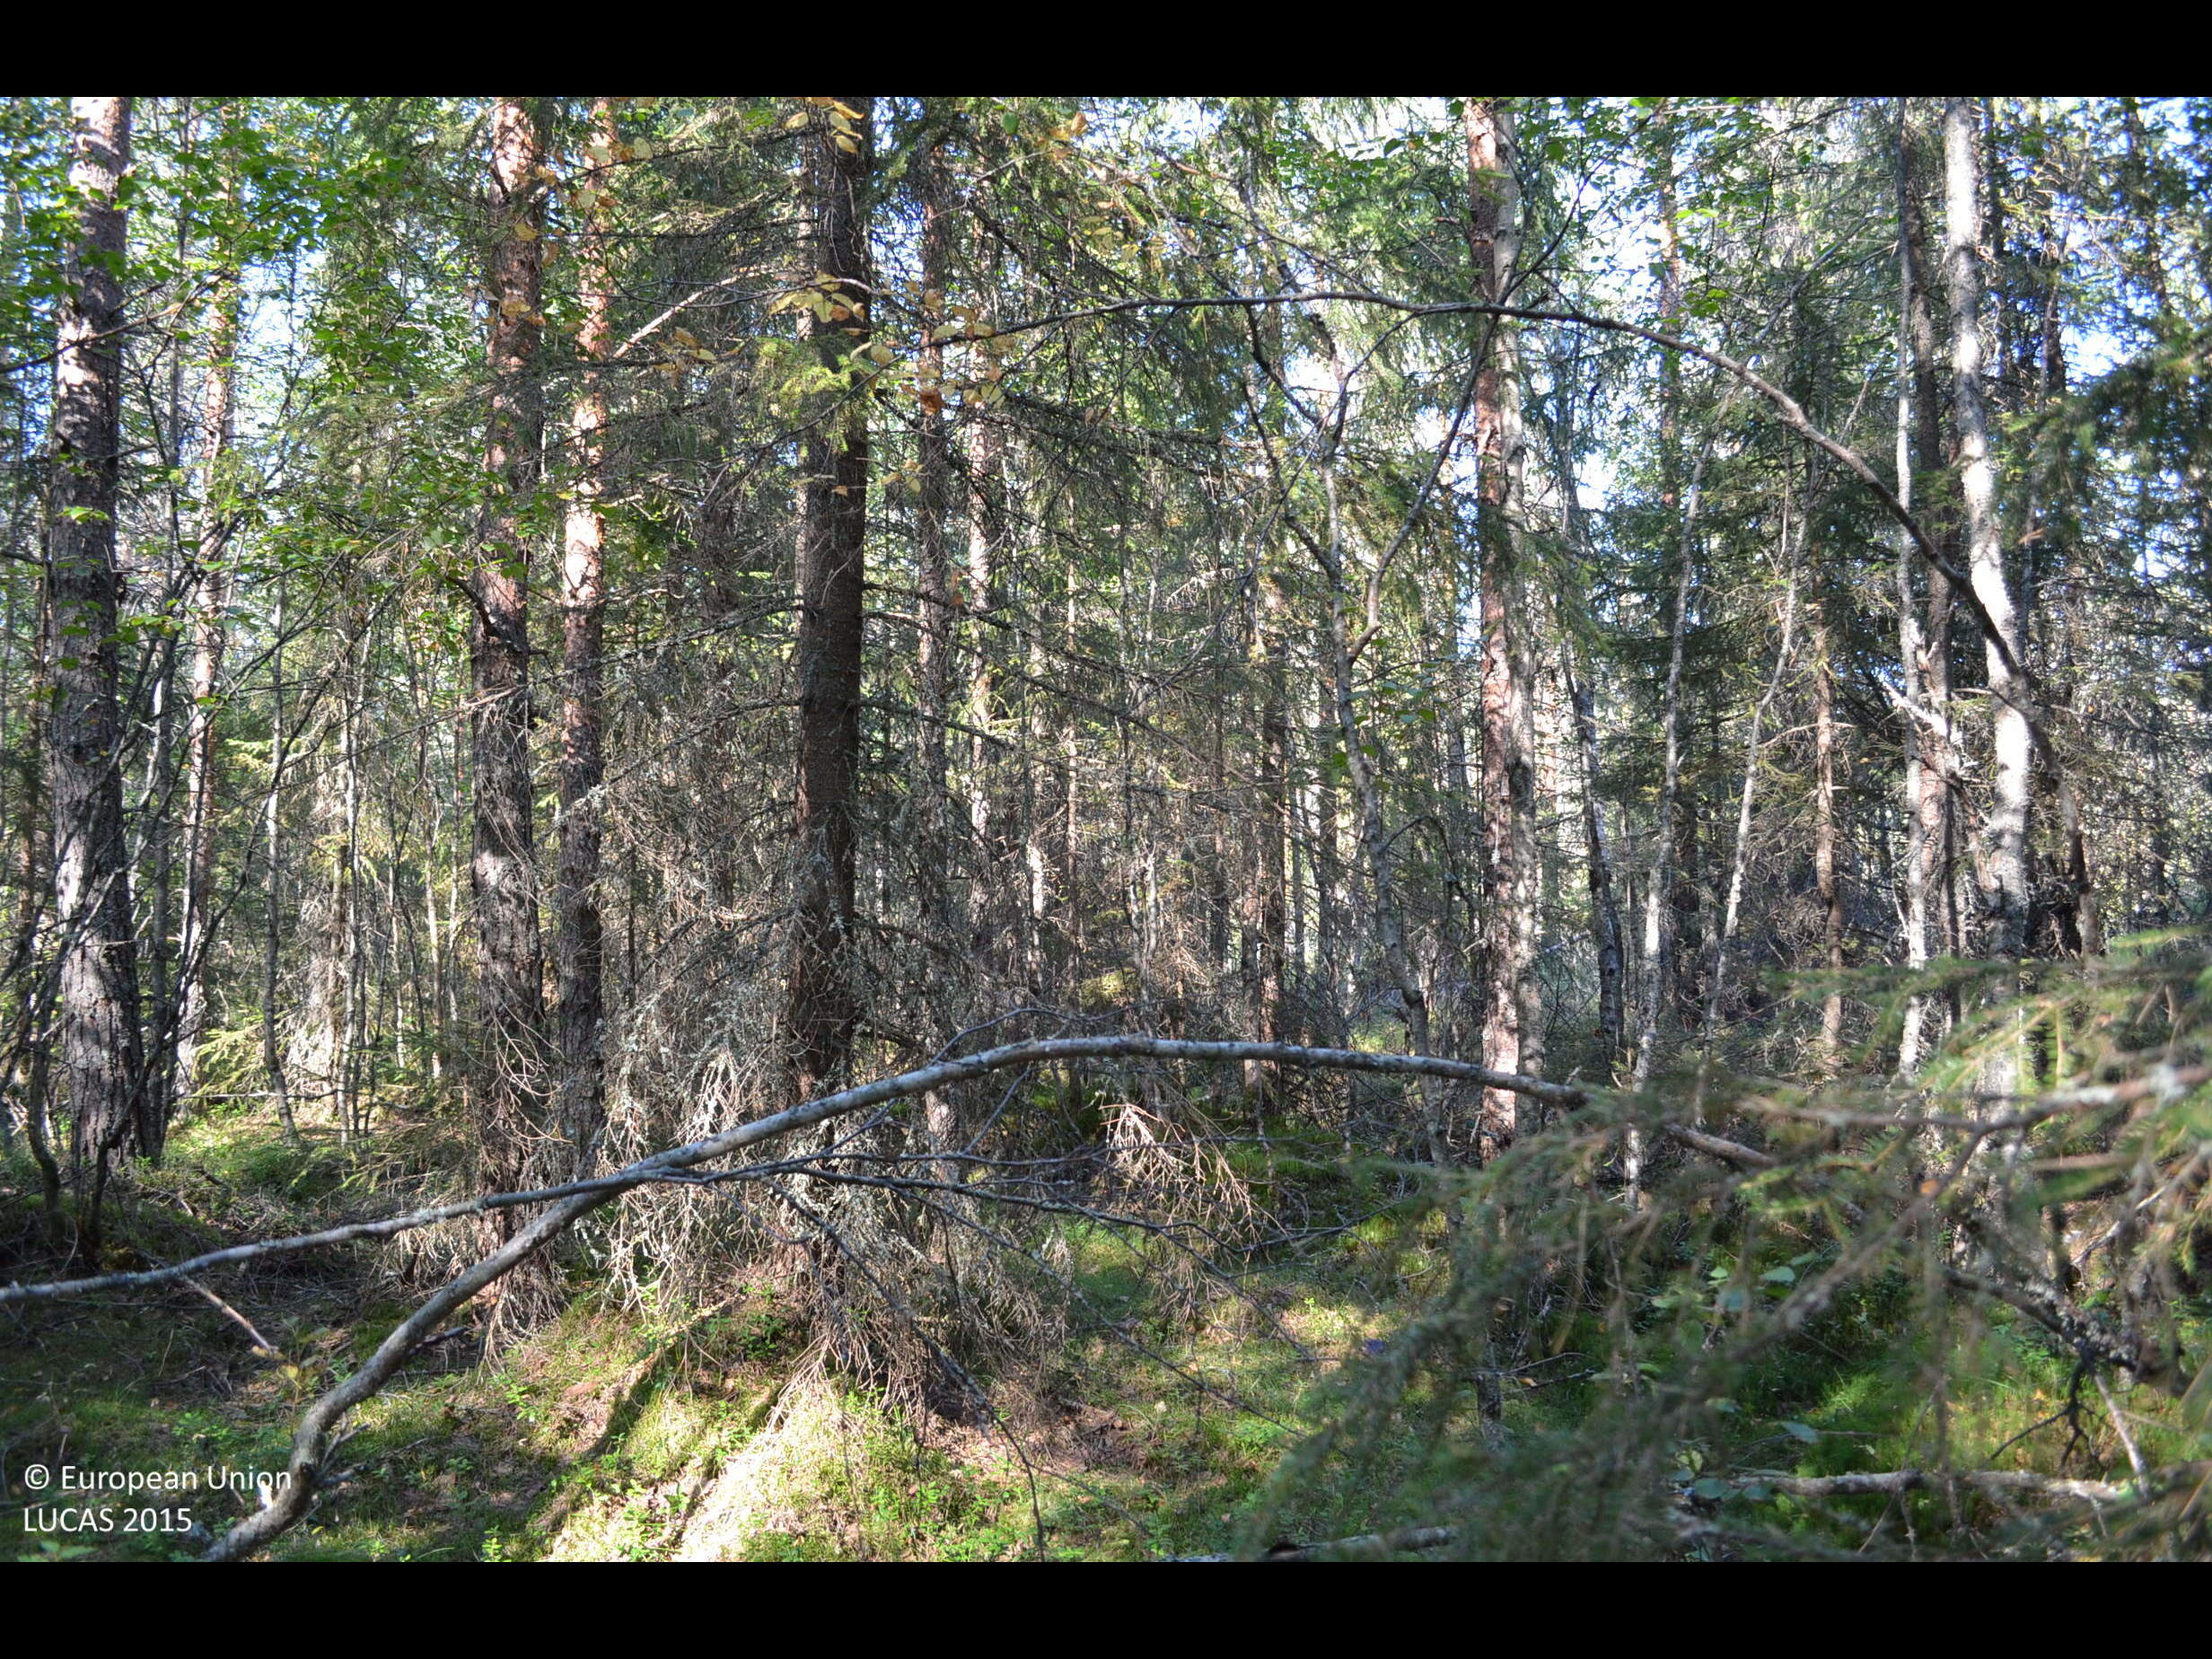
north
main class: Woodland
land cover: Pine dominated mixed woodland
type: boreal forest
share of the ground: > 75 %
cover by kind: coniferous forest trees 60 %, broadleaved forest trees 25 %, shrubs 5 %, lichens and mosses 5 %
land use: Forestry
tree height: > 5 m
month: August
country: FI
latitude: 62.4723
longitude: 24.3418
